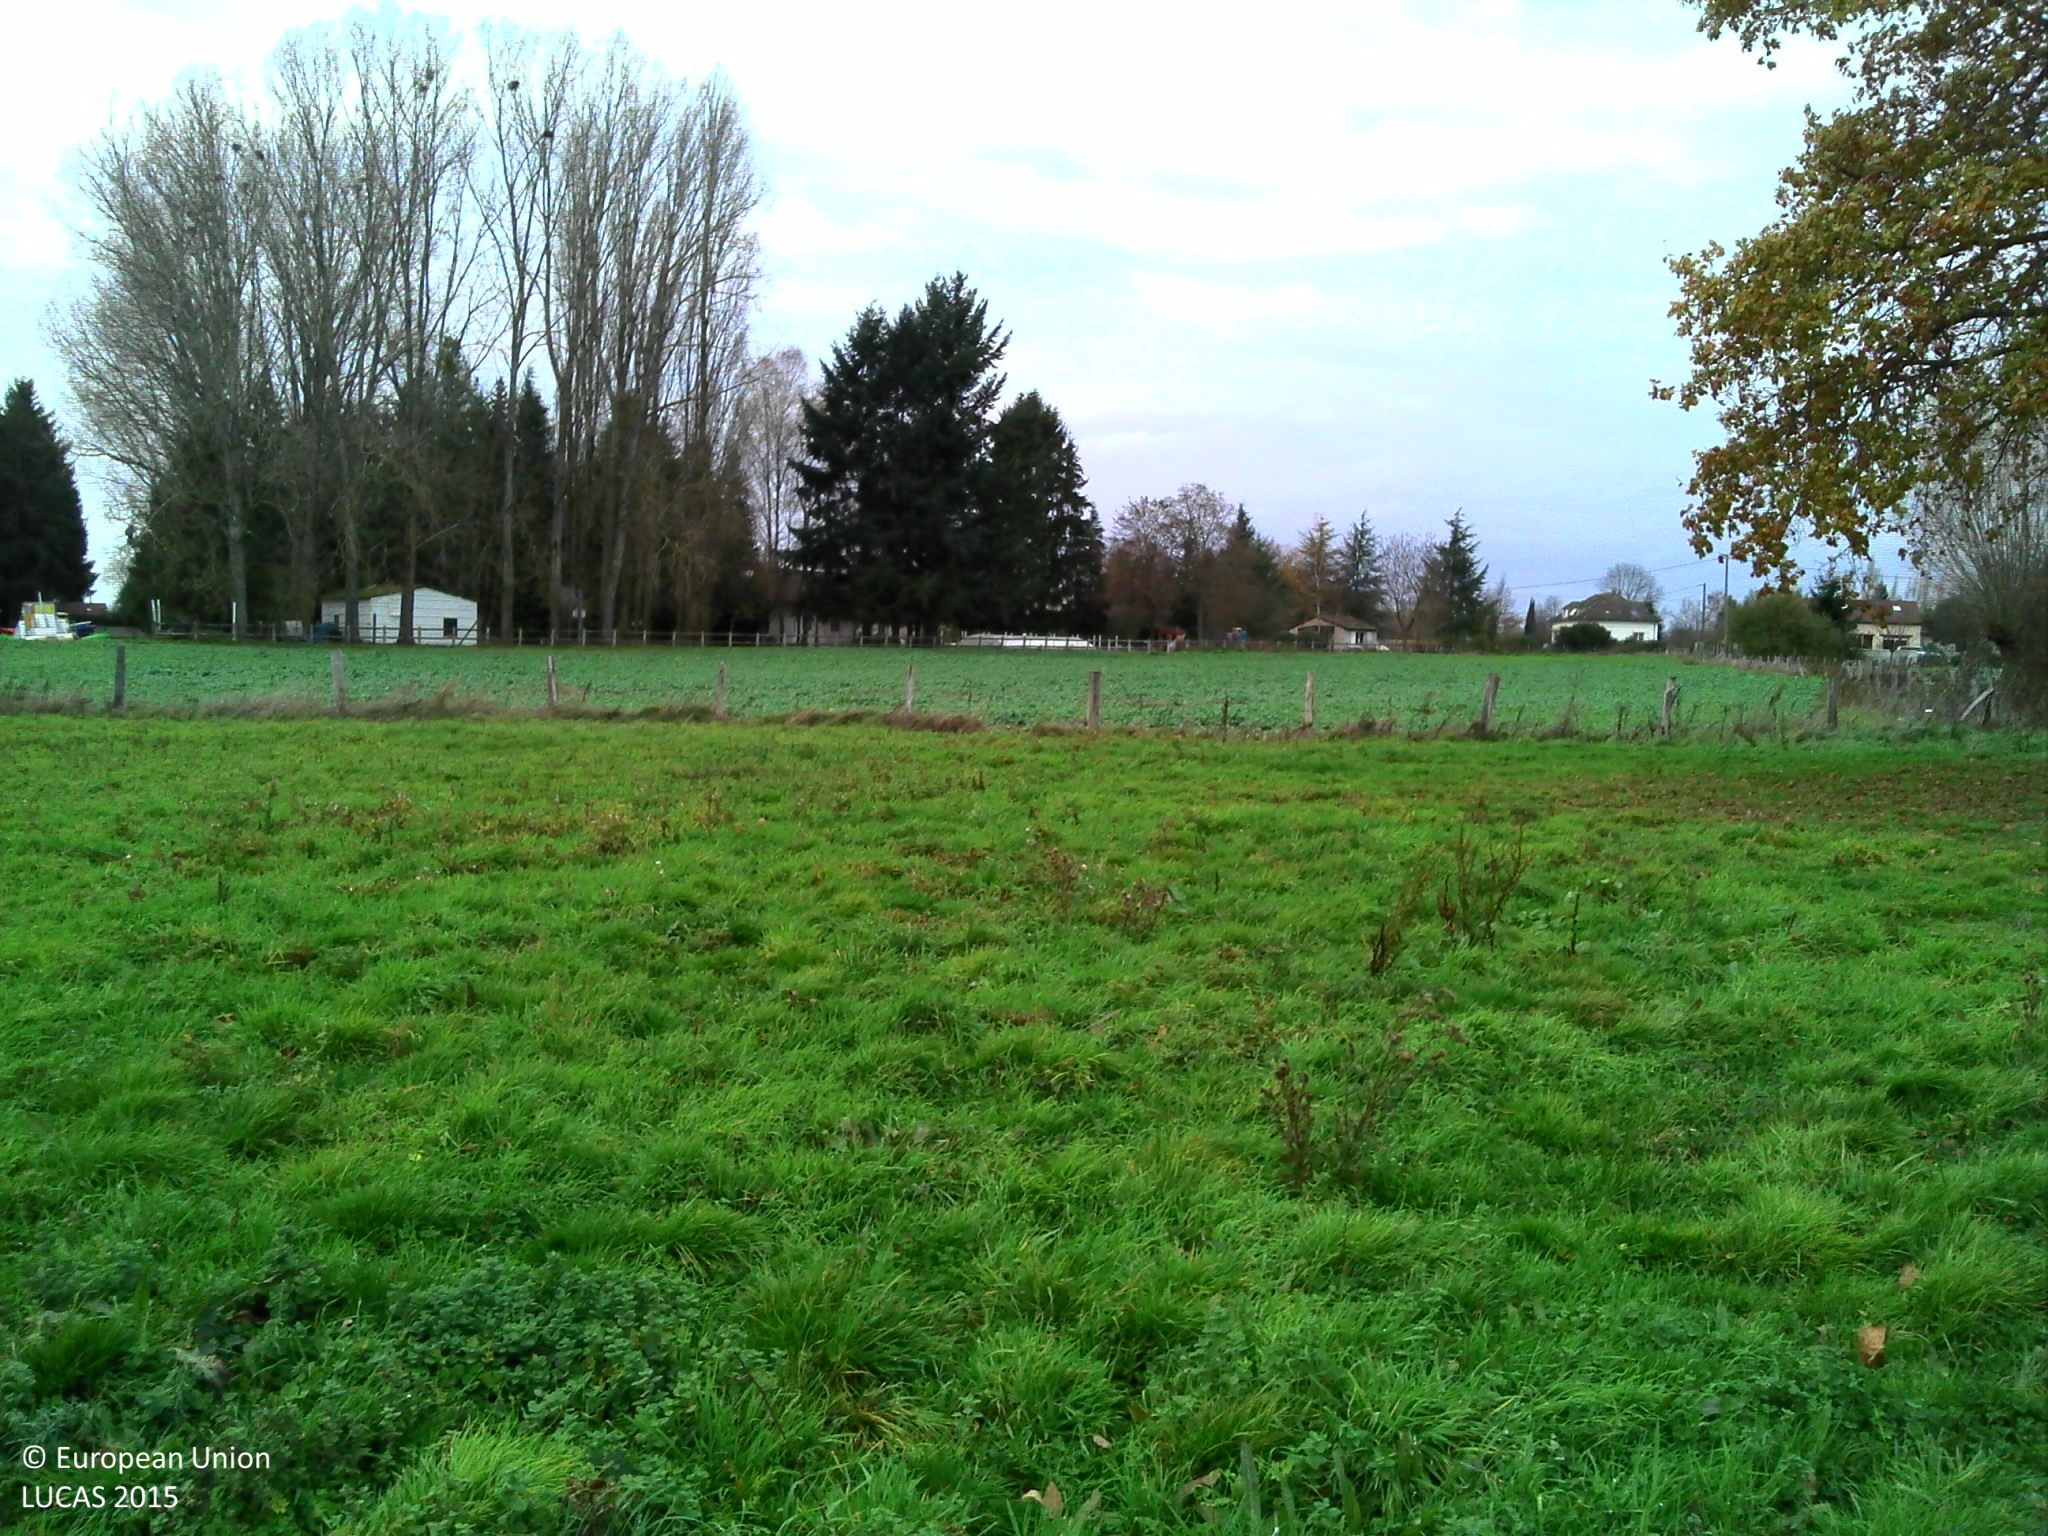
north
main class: Grassland
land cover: Grassland without tree/shrub cover
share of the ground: > 75 %
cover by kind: herbaceous plants 100 %
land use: Agriculture (excluding fallow land and kitchen gardens)
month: November
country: FR
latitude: 46.6108
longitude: 3.2998
